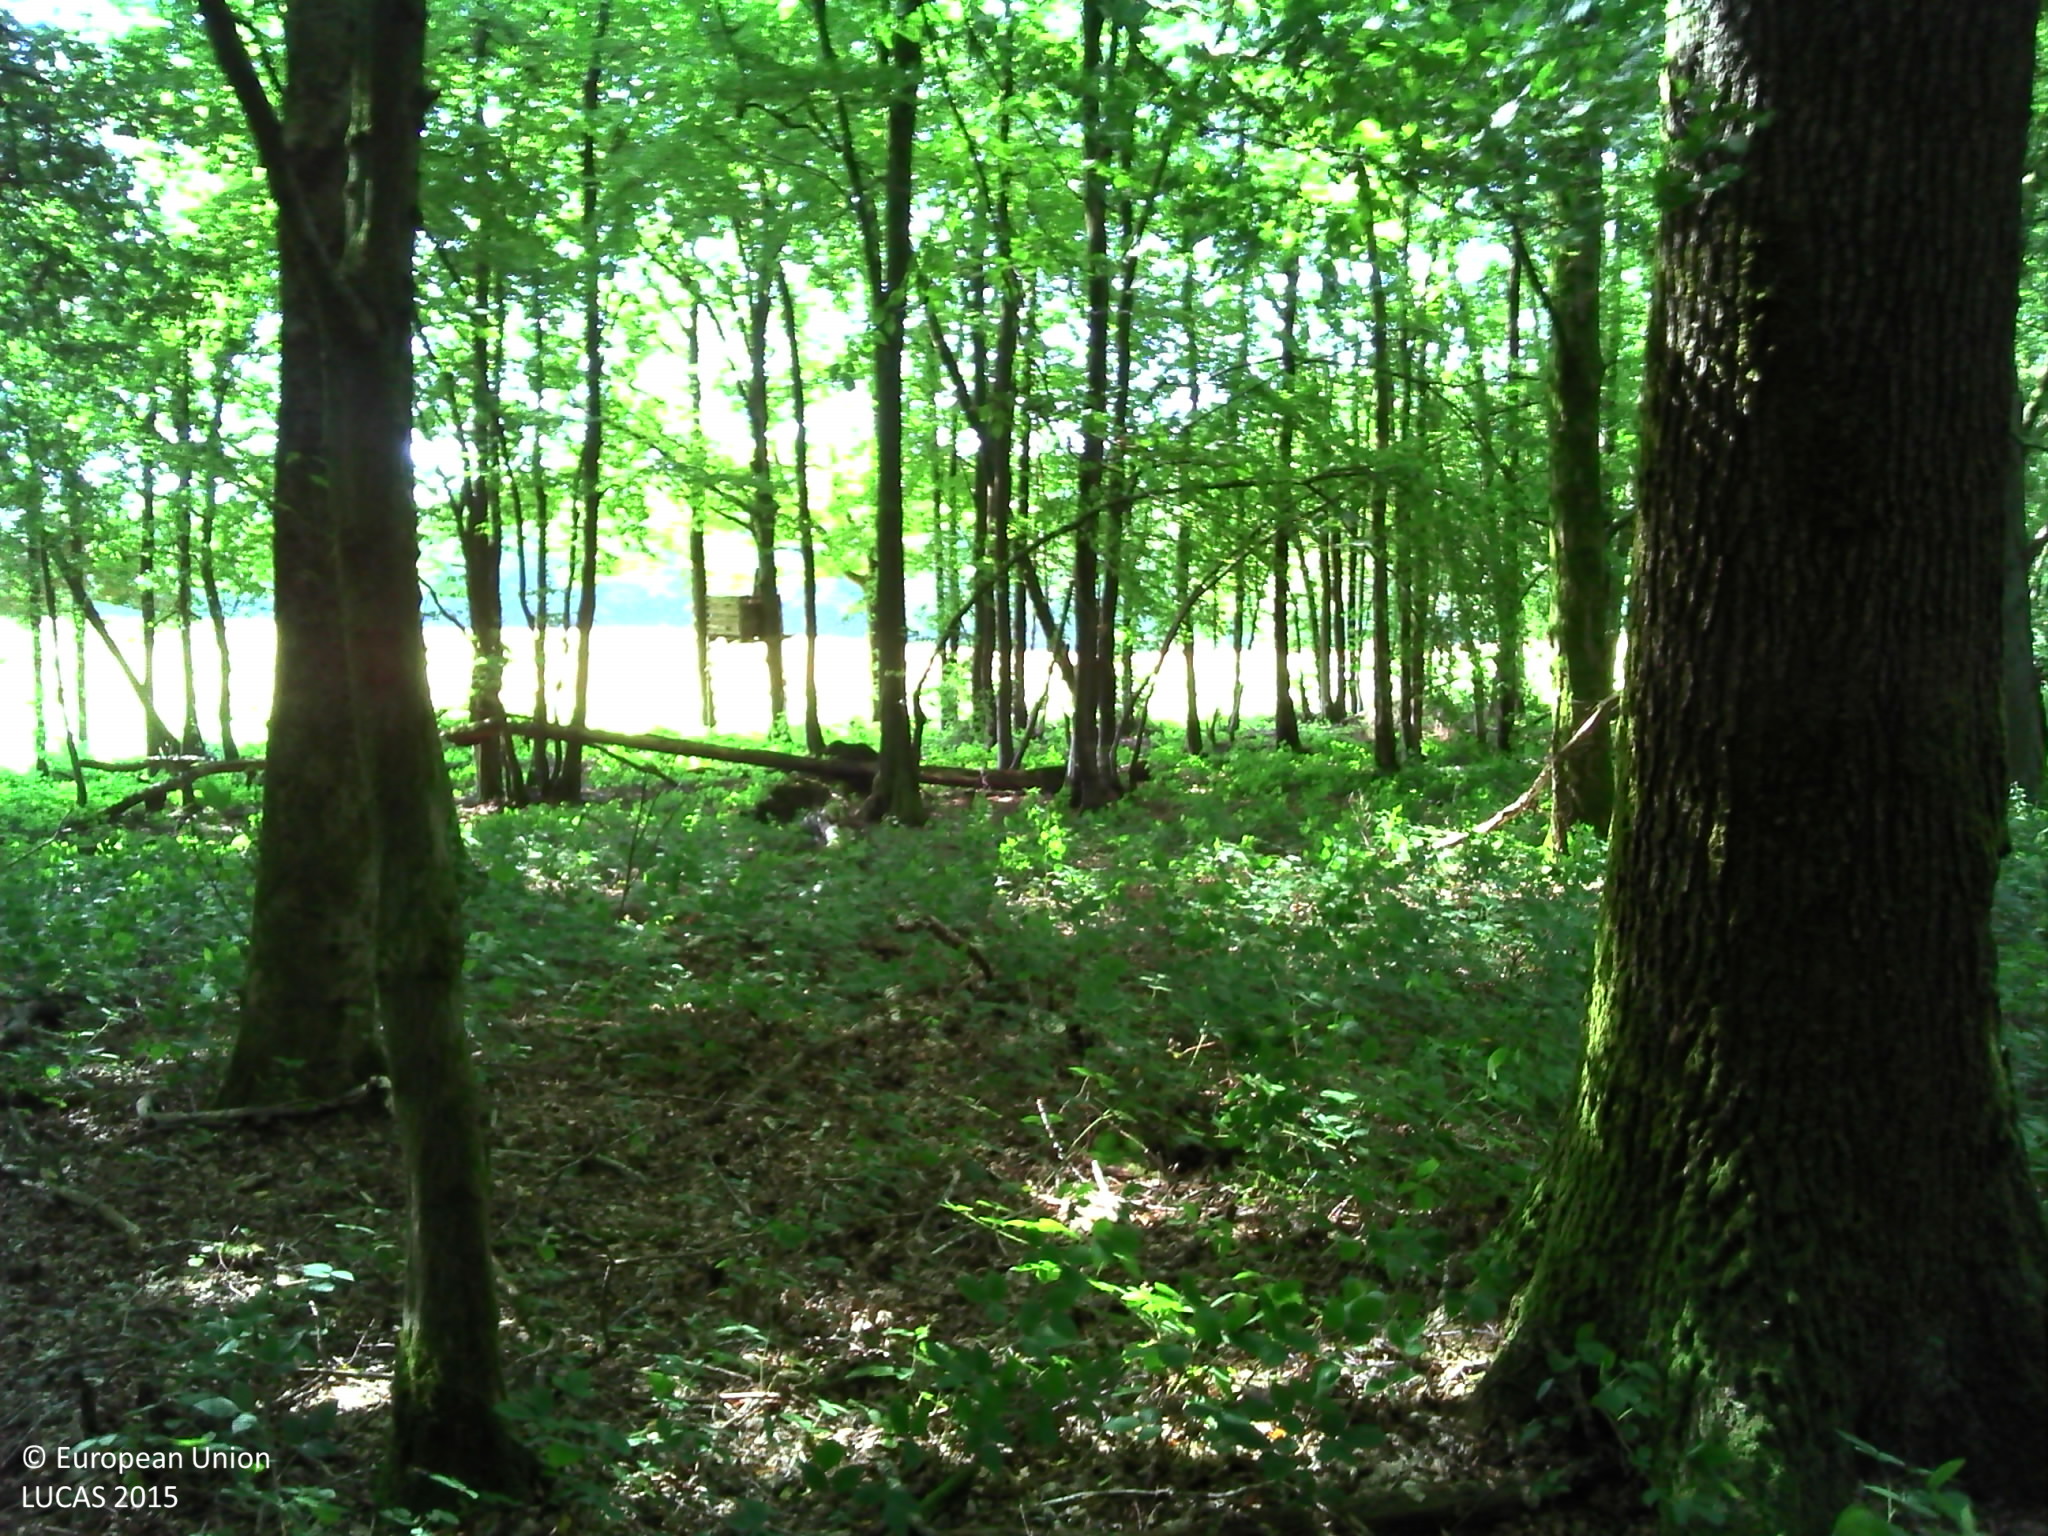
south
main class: Woodland
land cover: Broadleaved woodland
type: acidophilous oak and oak-birch forest
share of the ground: > 75 %
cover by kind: broadleaved forest trees 70 %, herbaceous plants 15 %, coniferous forest trees 5 %, lichens and mosses 5 %, consolidated bare surface 5 %
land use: Forestry
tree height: > 5 m
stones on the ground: < 10 %
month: August
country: FR
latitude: 50.1951
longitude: 4.1254
